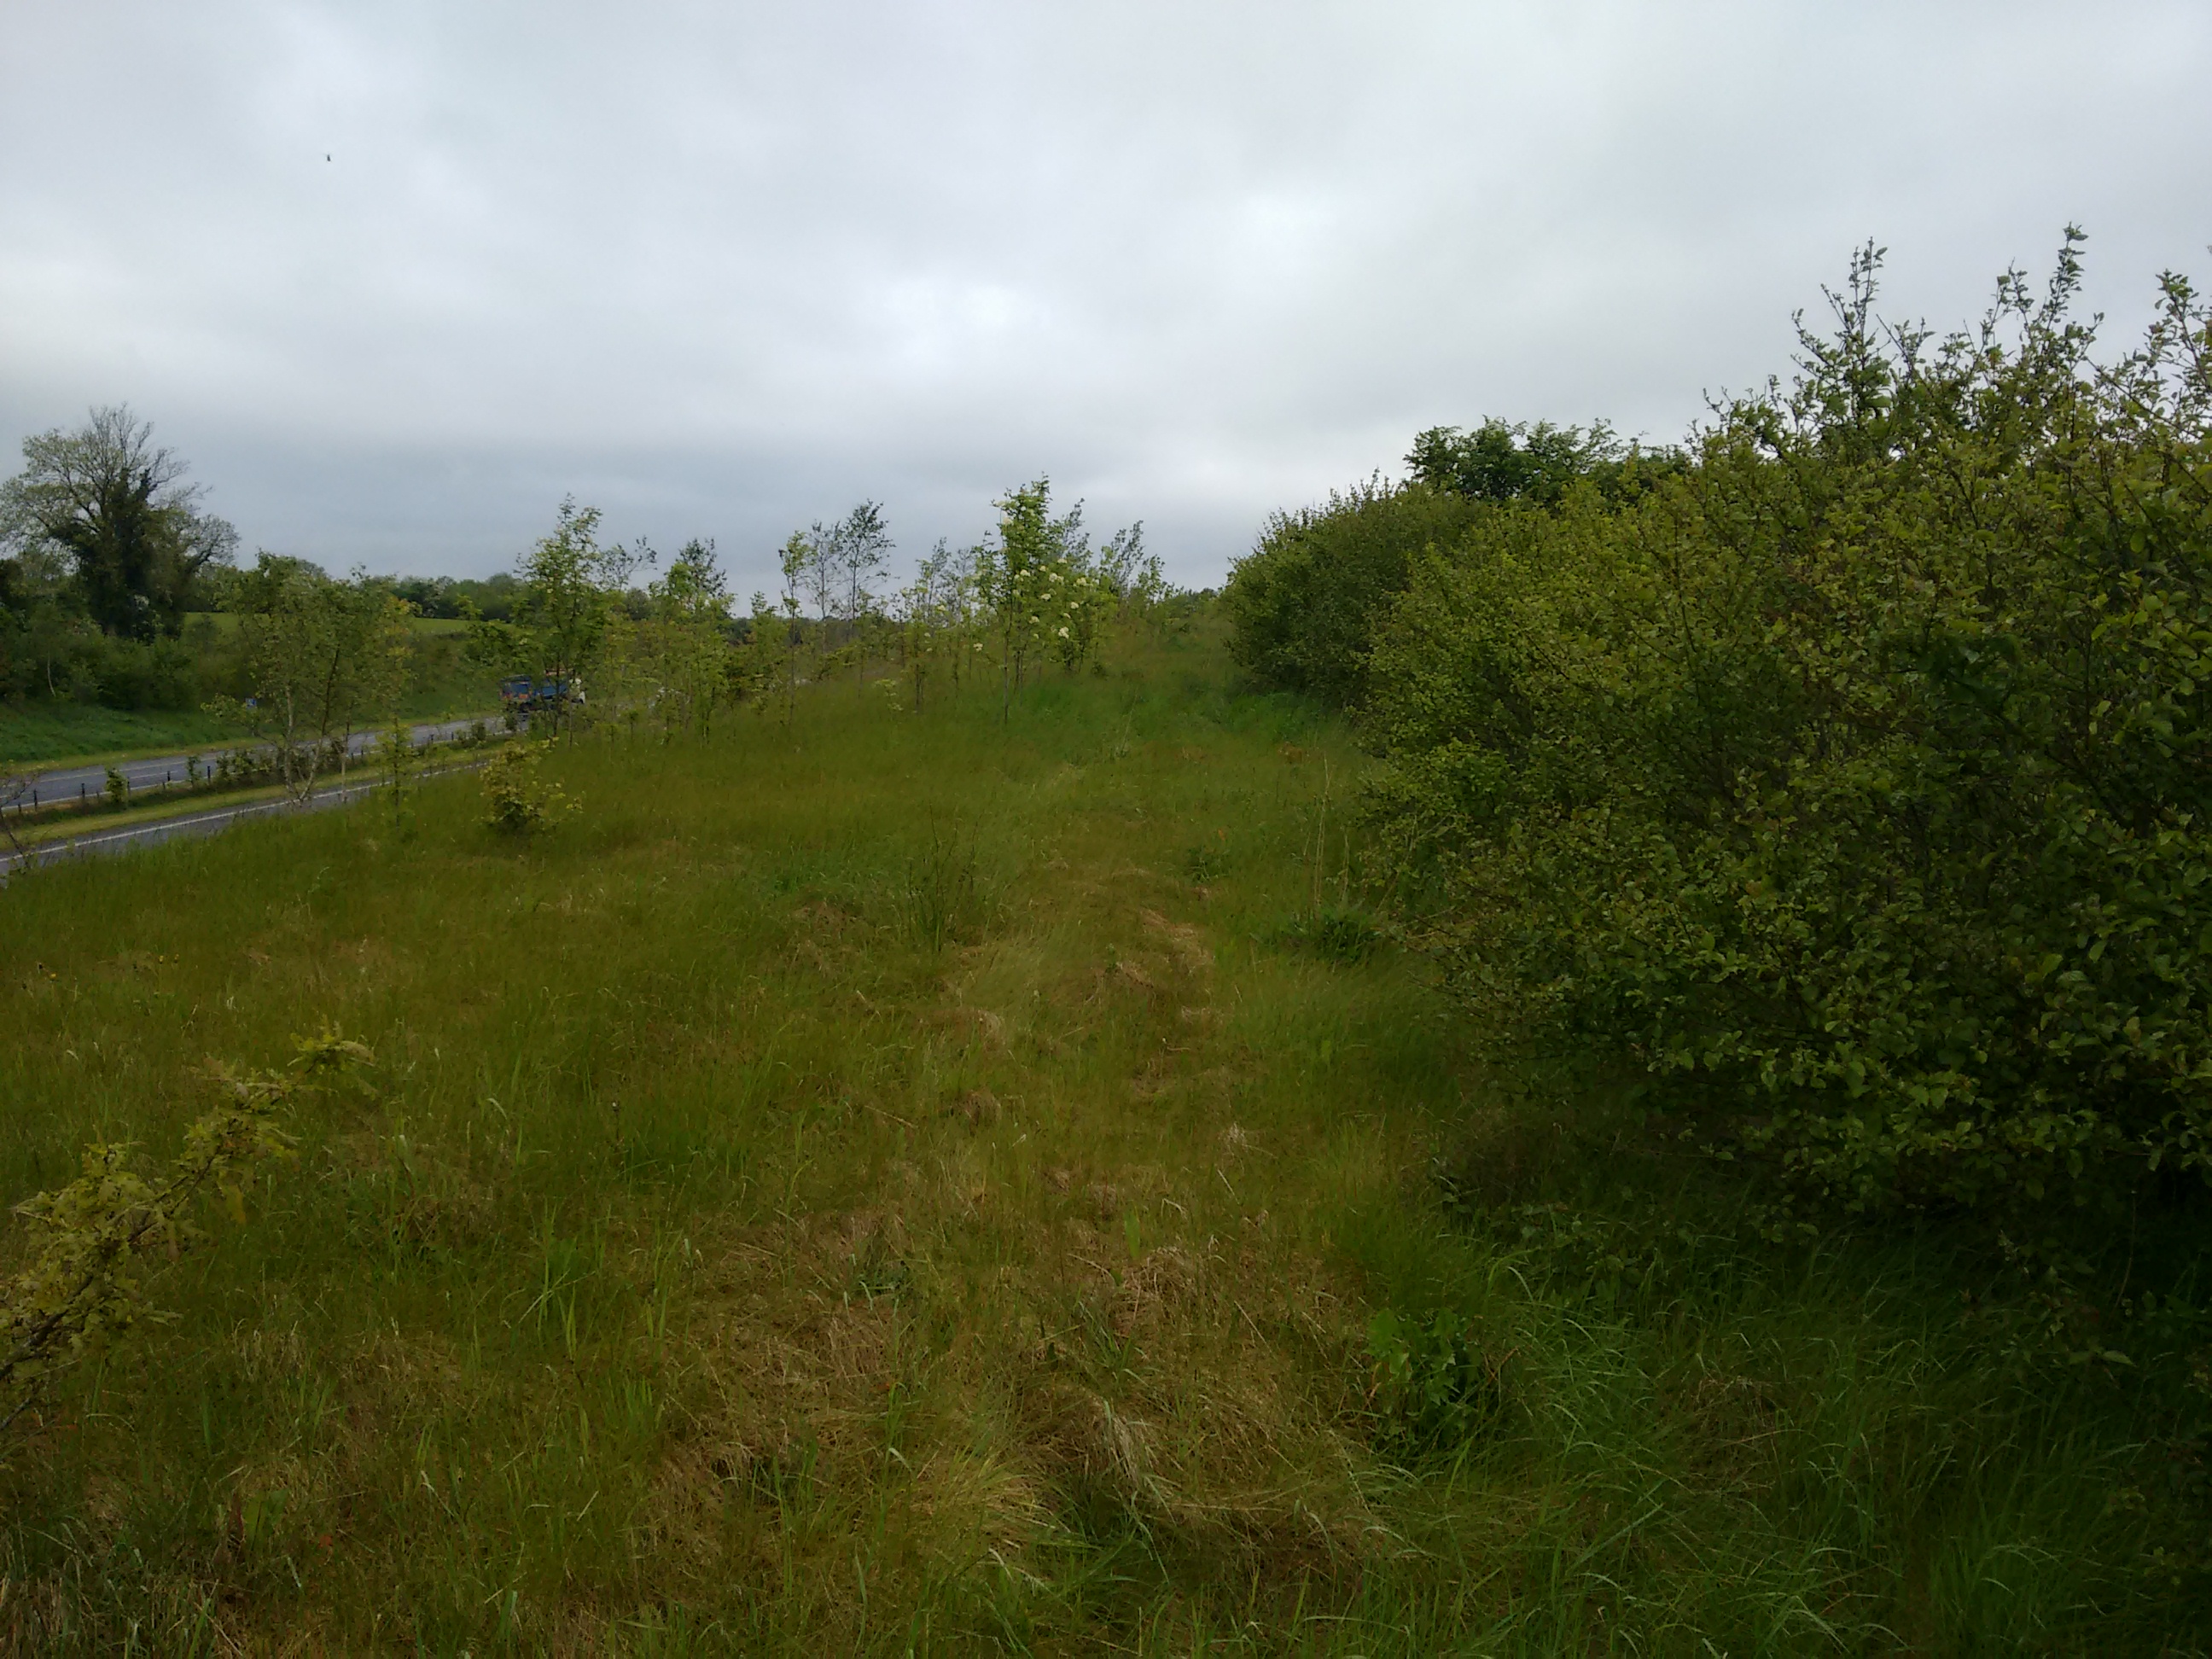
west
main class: Grassland
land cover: Grassland with sparse tree/shrub cover
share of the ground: > 75 %
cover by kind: herbaceous plants 85 %, shrubs 10 %, broadleaved forest trees 5 %
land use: Road transport
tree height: < 5 m
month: May
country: IE
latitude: 53.4268
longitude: -6.9507
